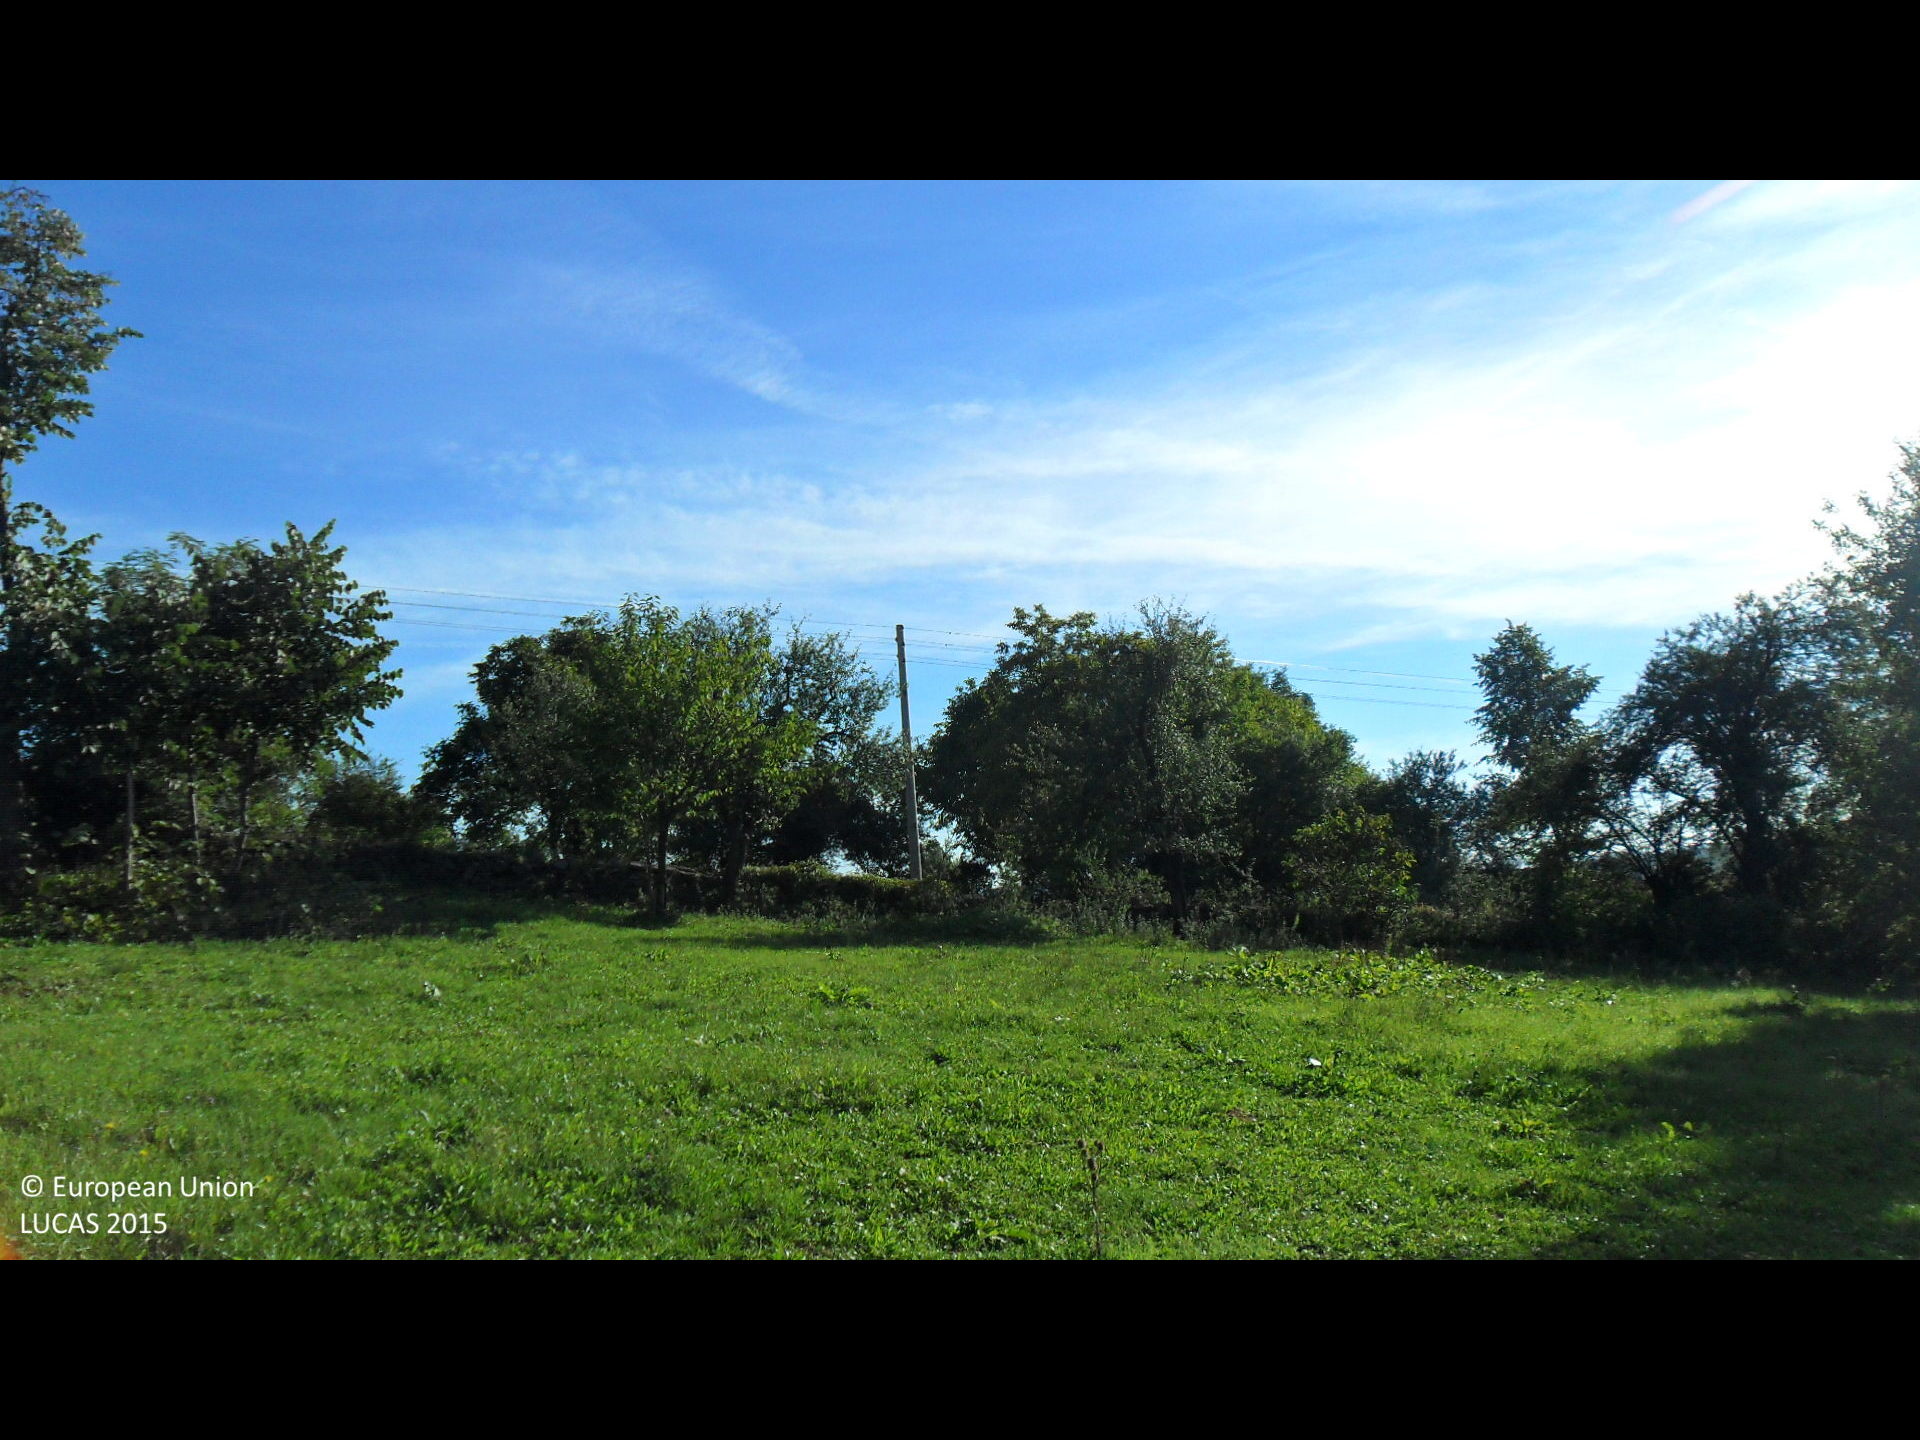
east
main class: Grassland
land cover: Grassland without tree/shrub cover
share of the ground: > 75 %
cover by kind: herbaceous plants 100 %
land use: Agriculture (excluding fallow land and kitchen gardens)
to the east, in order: Grassland without tree/shrub cover; Managed hedges; Tracks; Electric lines; Broadleaved woodland; Grassland with sparse tree/shrub cover; Artificial constructions in urban areas
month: October
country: BG
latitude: 43.0746
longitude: 26.2689
